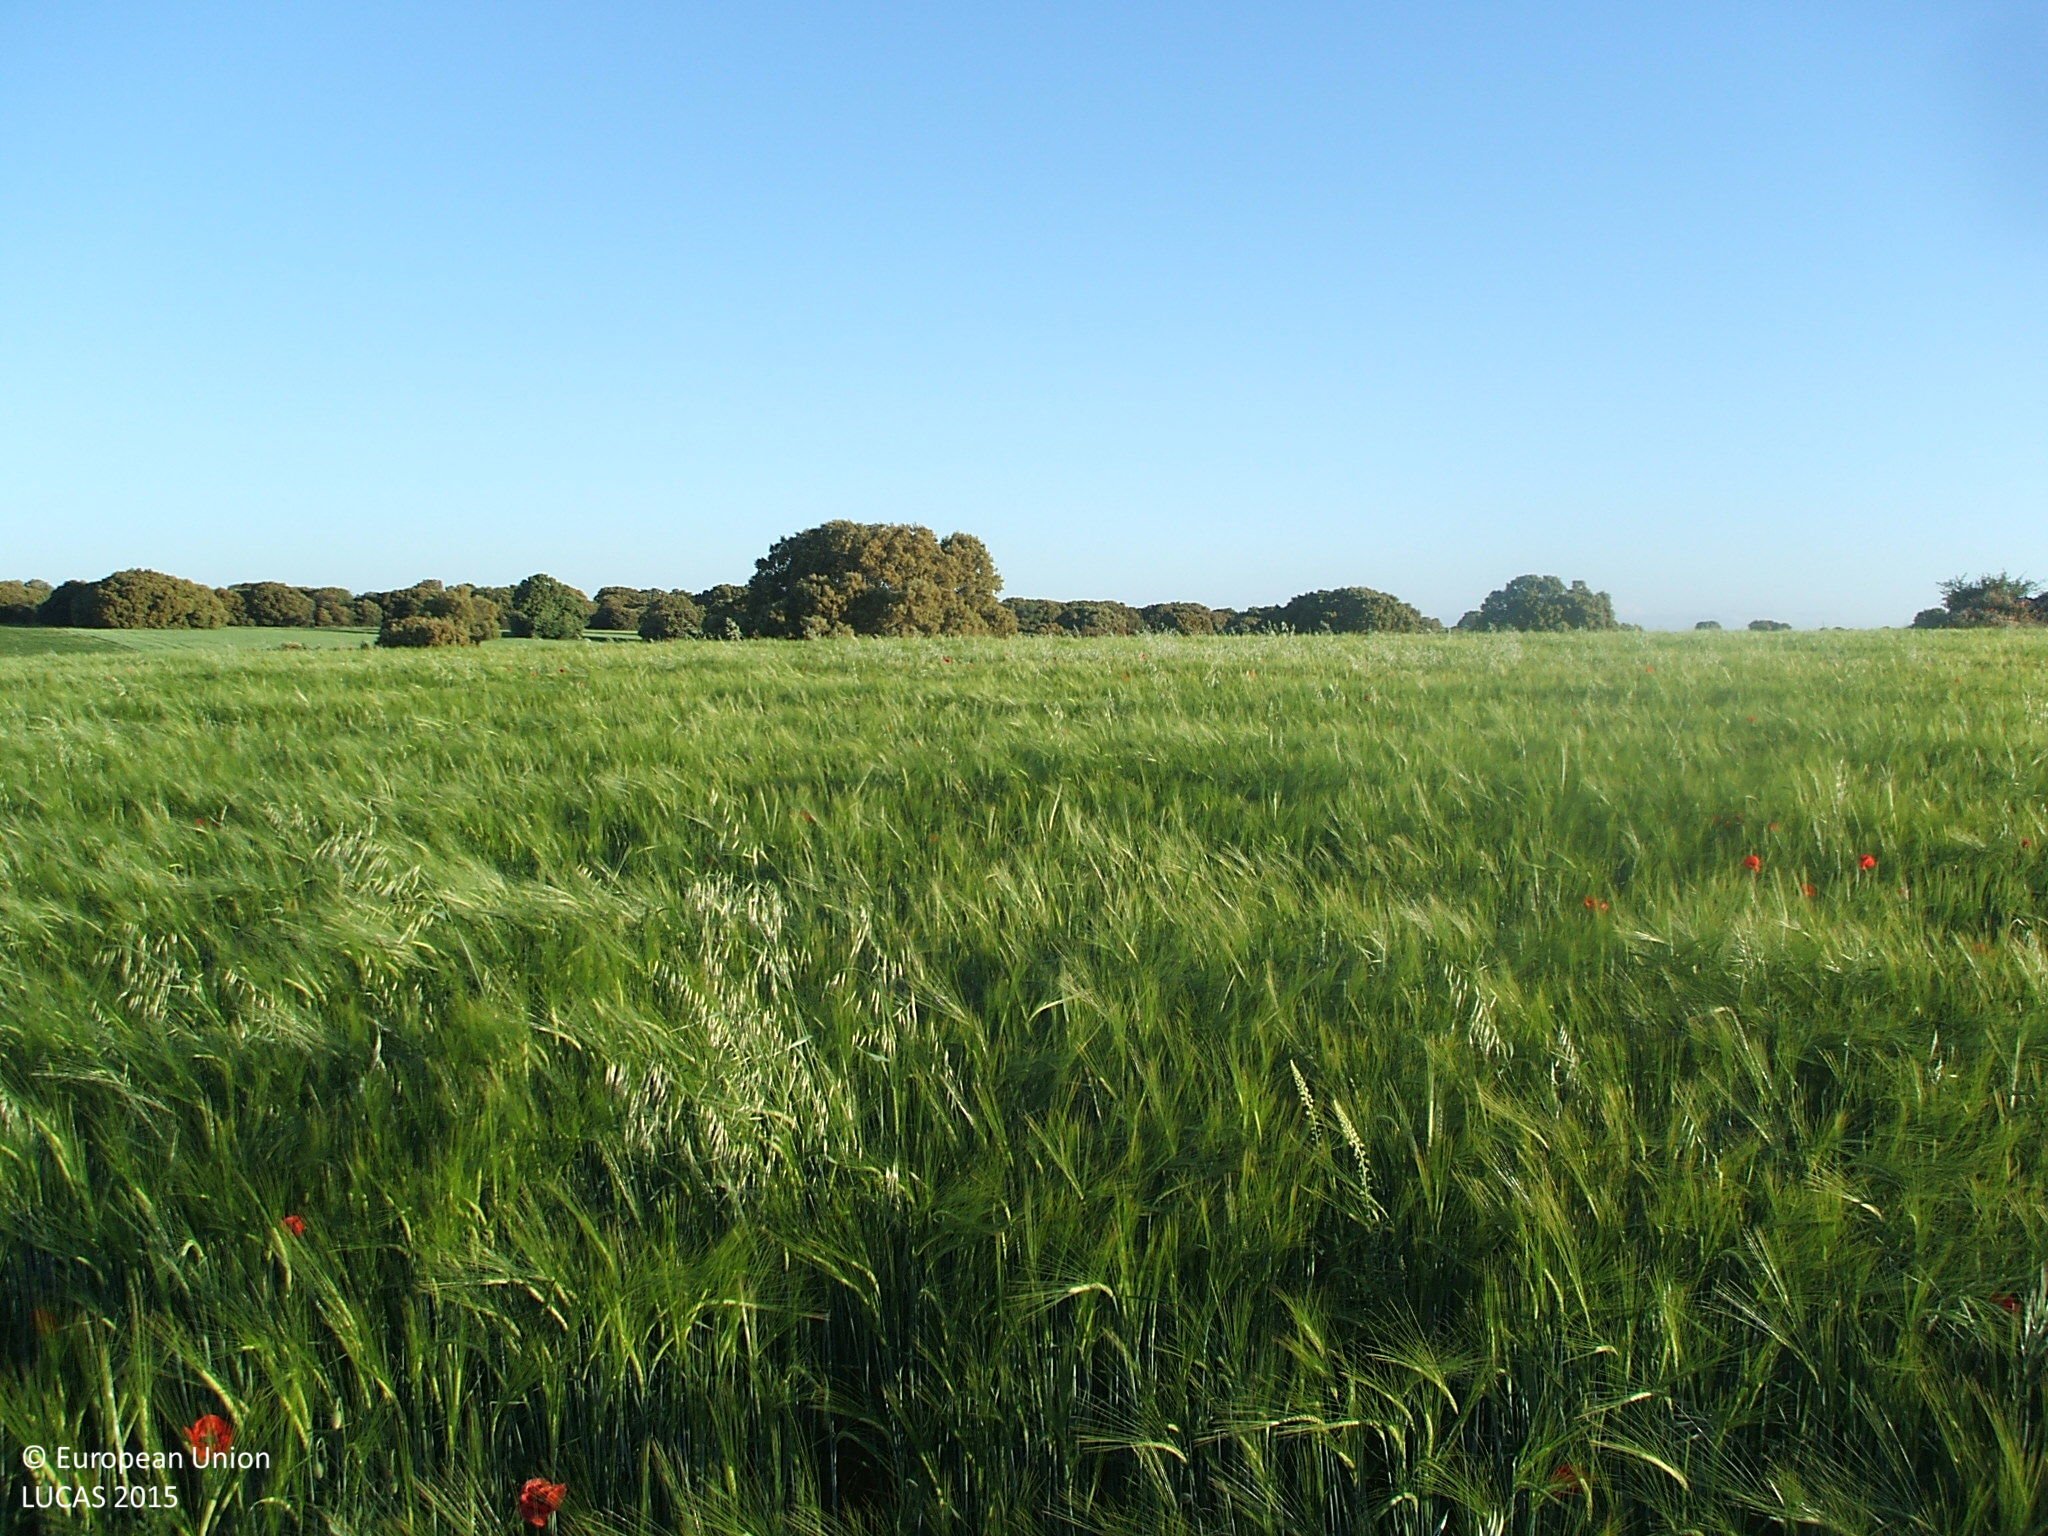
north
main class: Cropland
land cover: Barley
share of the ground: > 75 %
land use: Agriculture (excluding fallow land and kitchen gardens)
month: May
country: ES
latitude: 40.6605
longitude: -2.8636
